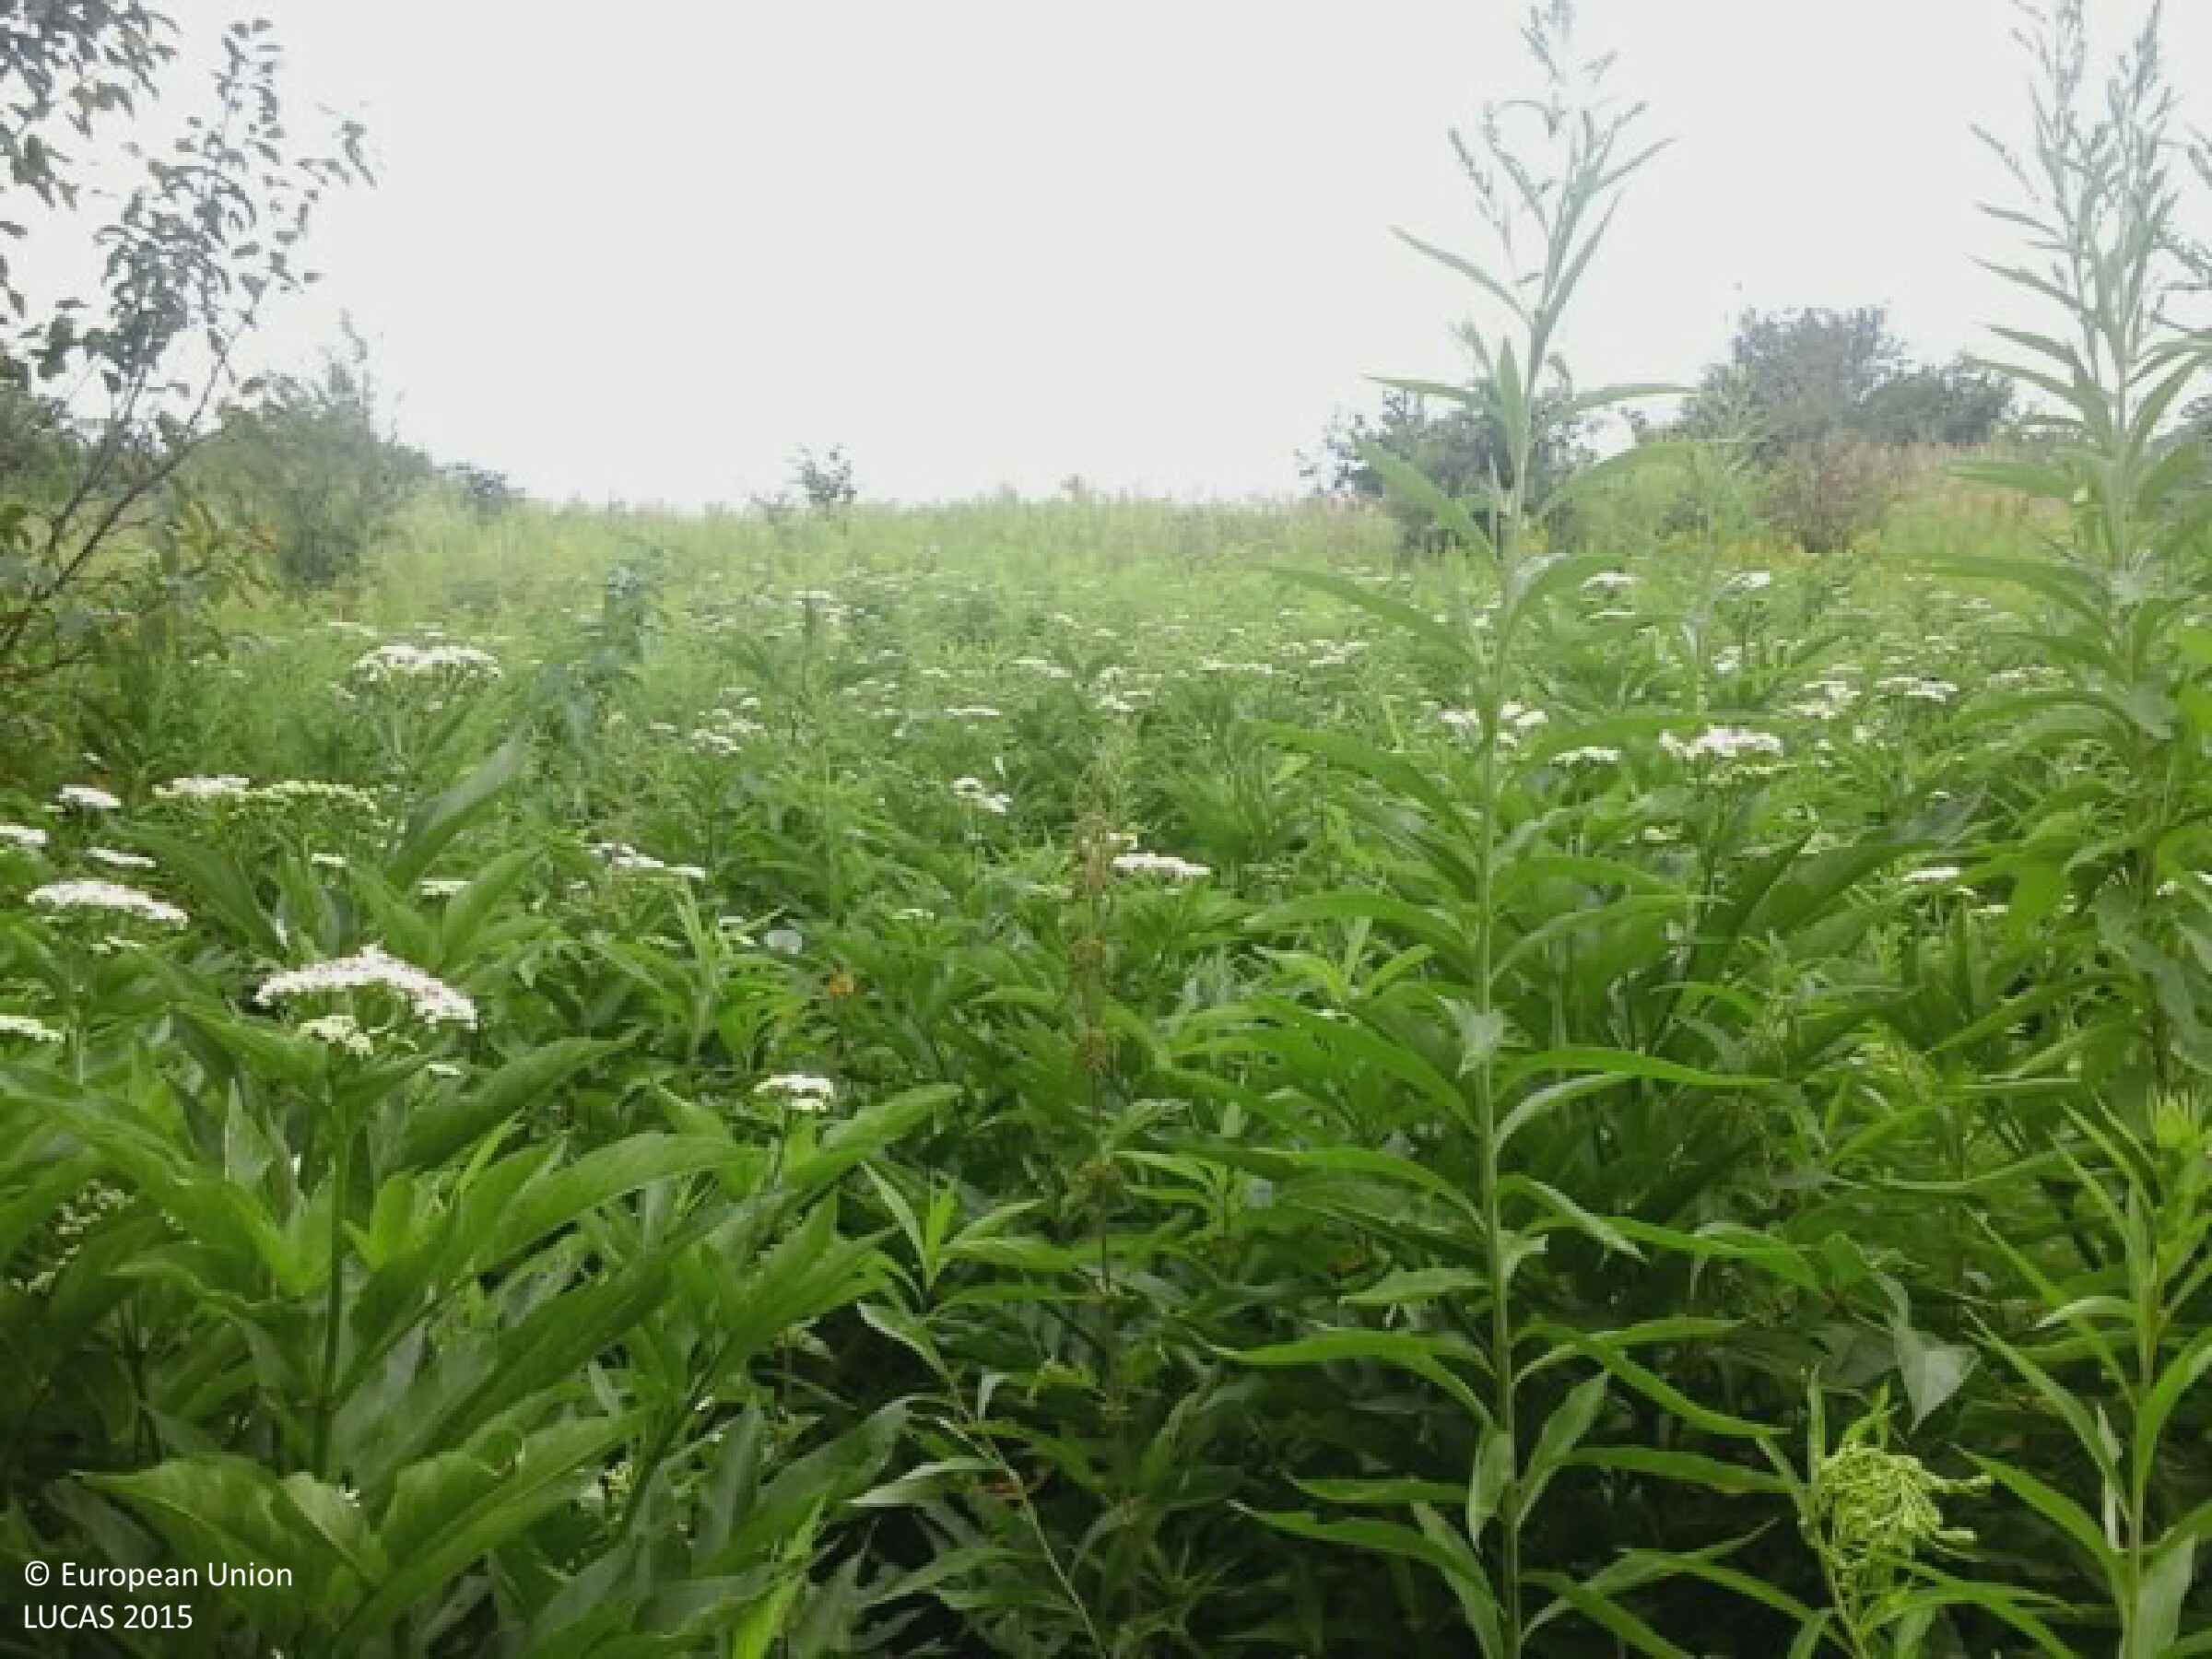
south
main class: Grassland
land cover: Spontaneously vegetated surfaces
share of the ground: > 75 %
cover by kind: herbaceous plants 95 %, shrubs 5 %
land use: Fallow land
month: August
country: HU
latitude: 46.2496
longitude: 18.0096
